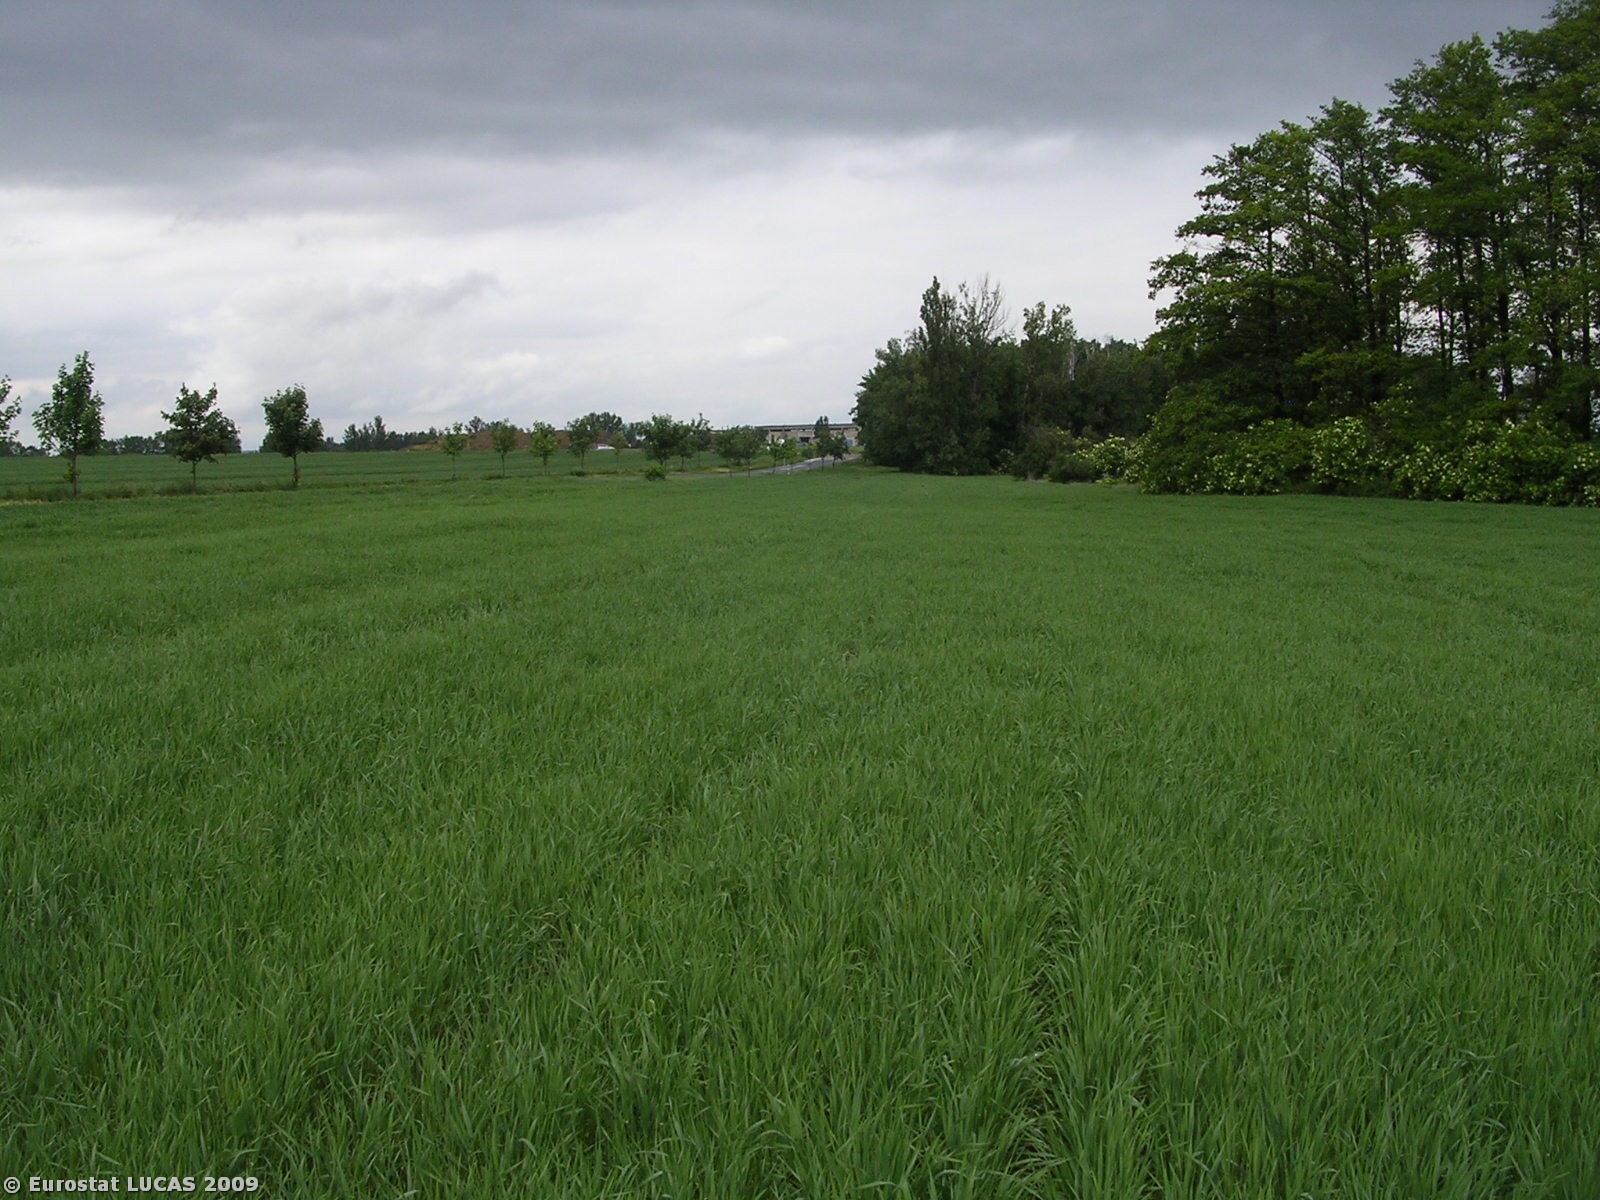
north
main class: Cropland
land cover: Barley
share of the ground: > 75 %
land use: Agriculture (excluding fallow land and kitchen gardens)
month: May
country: CZ
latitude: 50.2681
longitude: 14.2242
